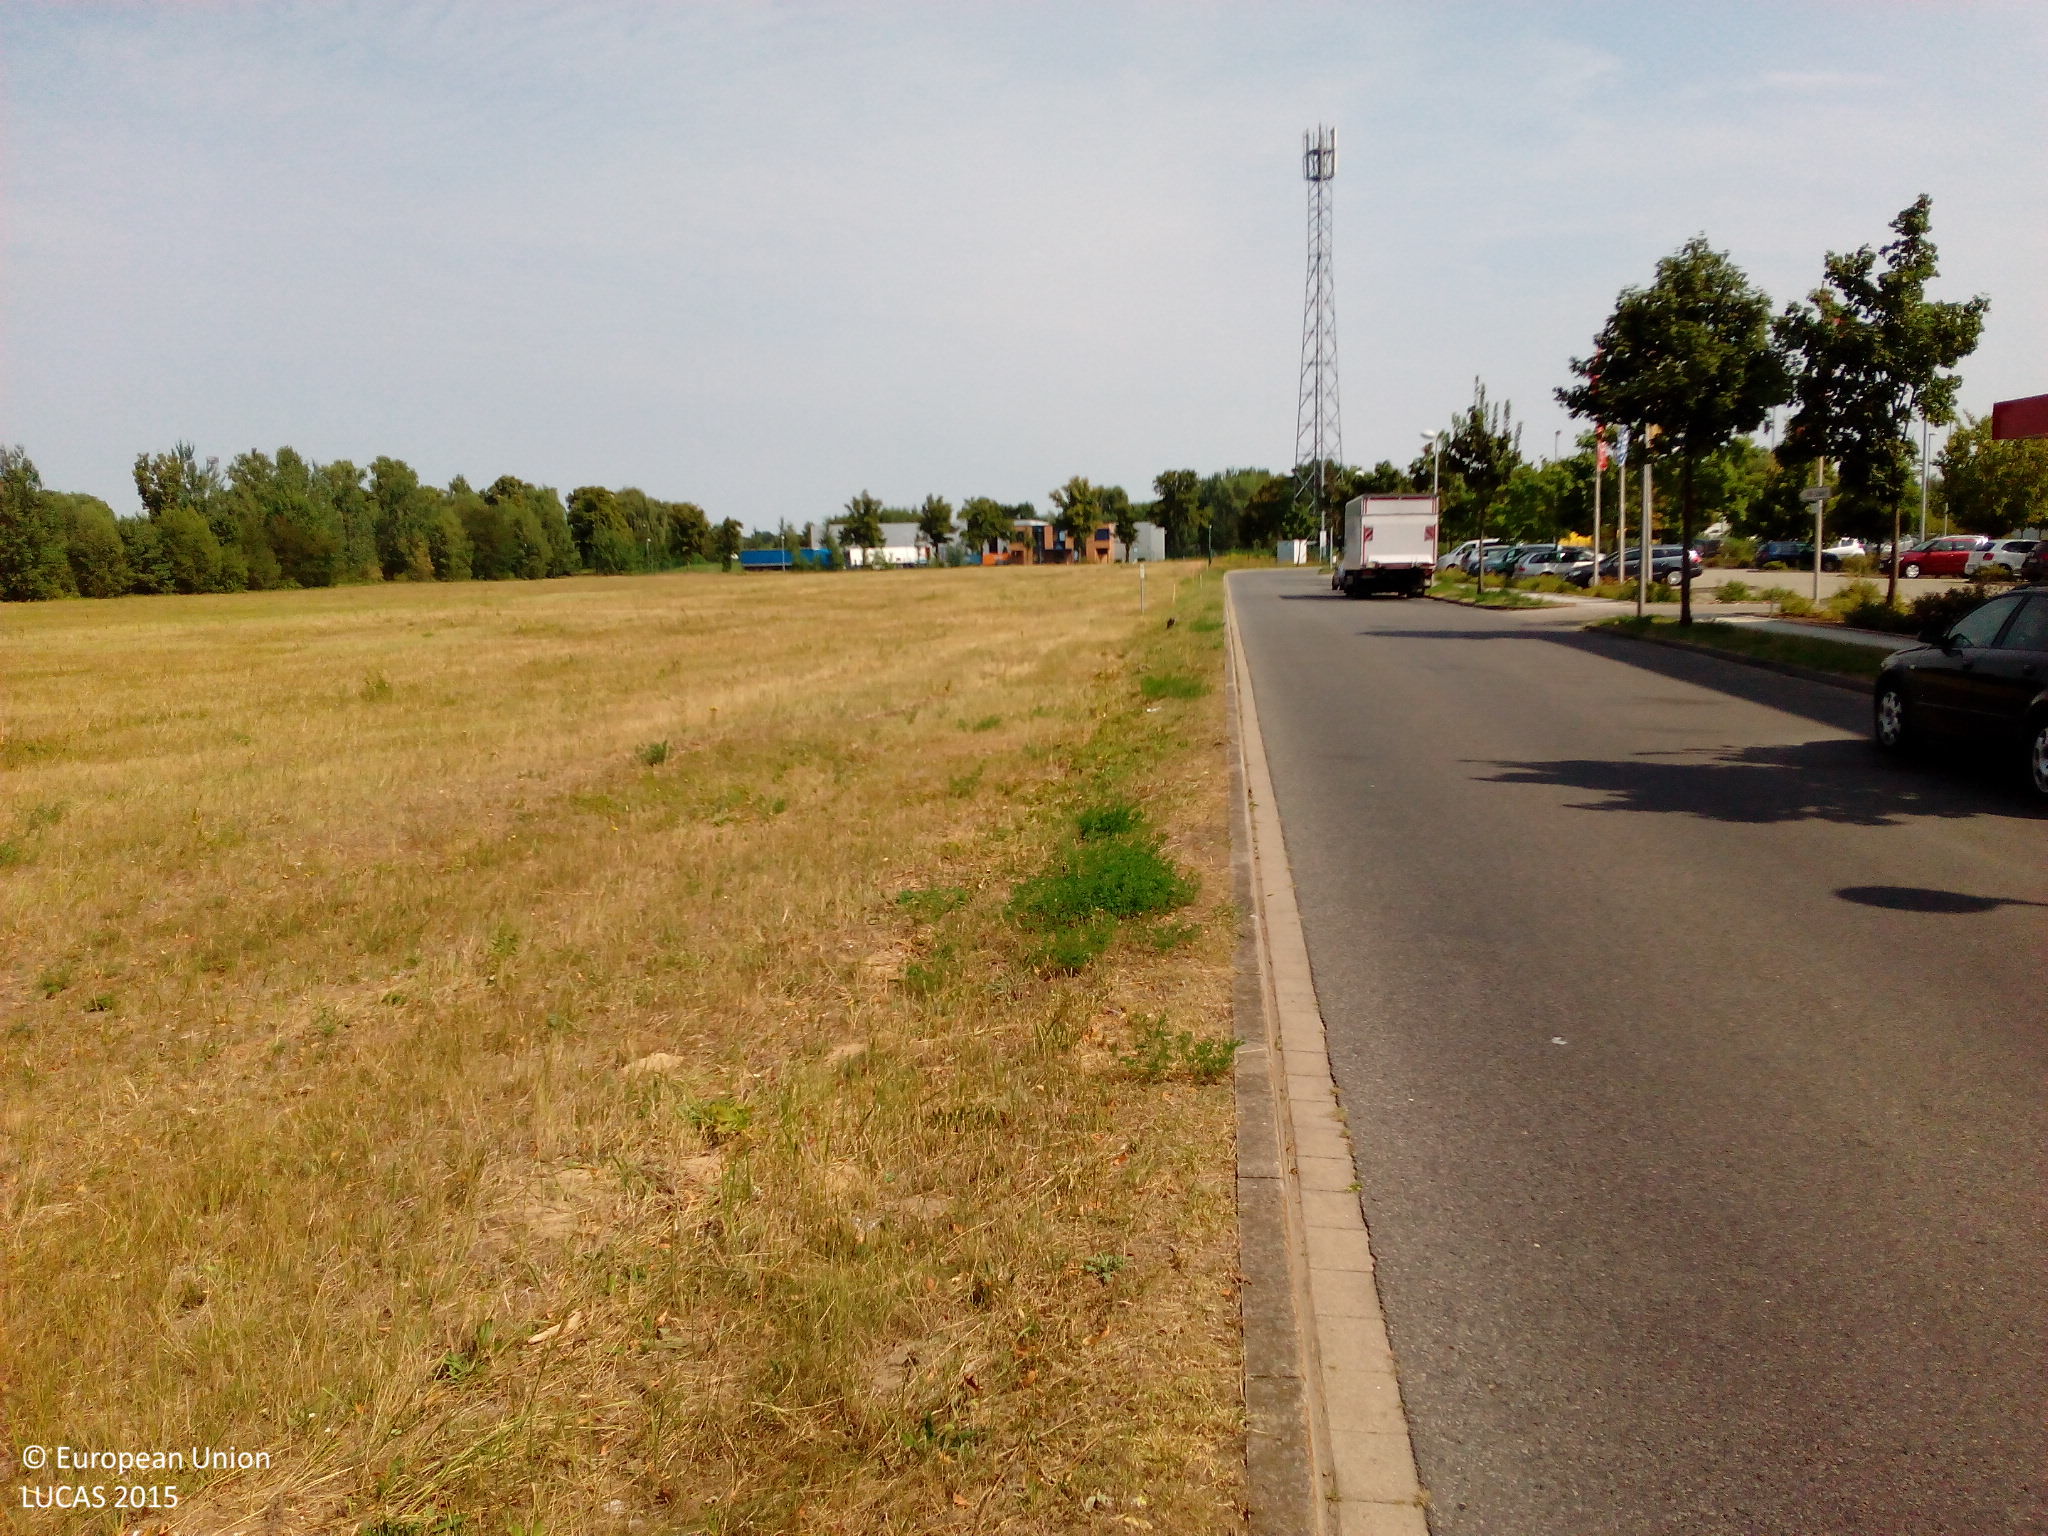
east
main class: Grassland
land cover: Grassland without tree/shrub cover
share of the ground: > 75 %
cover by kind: herbaceous plants 90 %, unconsolidated bare surface 10 %
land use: Machinery and equipment
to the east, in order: Grassland without tree/shrub cover
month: August
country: DE
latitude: 52.6221
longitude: 13.2054
